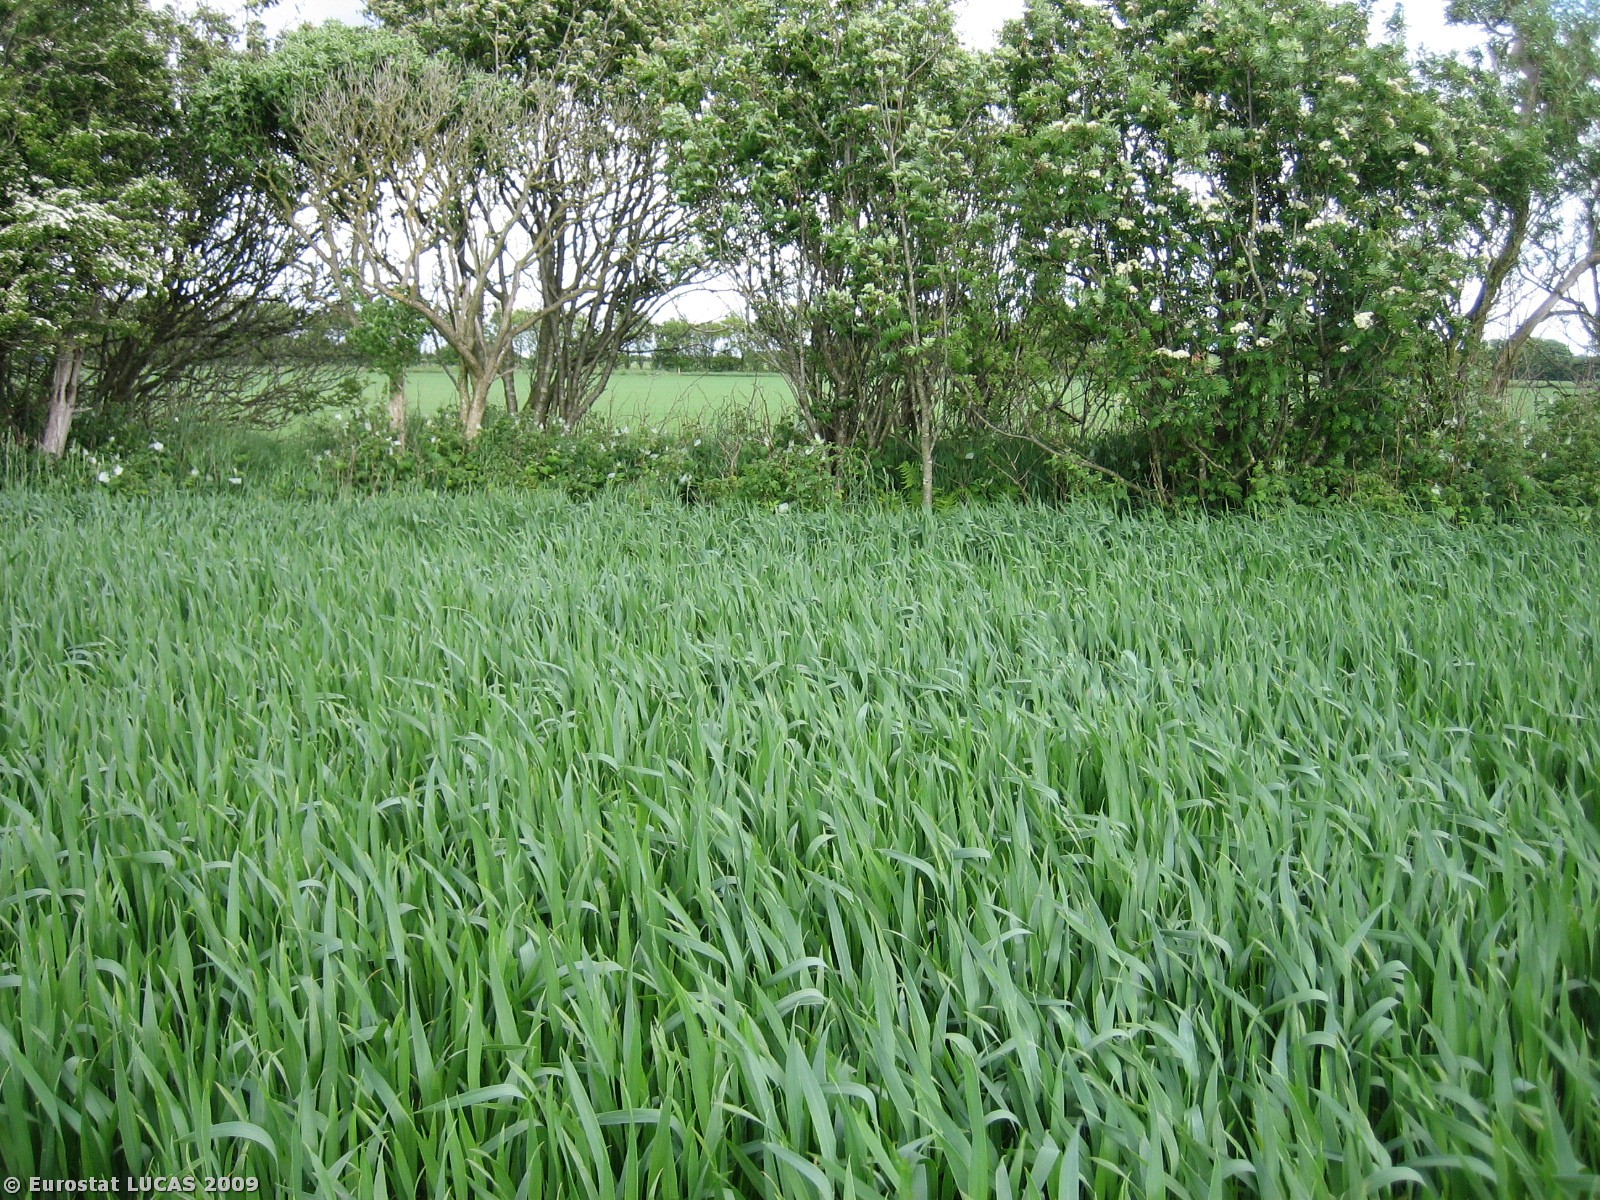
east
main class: Cropland
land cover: Barley
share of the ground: > 75 %
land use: Agriculture (excluding fallow land and kitchen gardens)
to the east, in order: Barley; Shrubland with sparse tree cover; Barley; Grass margins; Ditches and canals; Grass margins; Paved roads, cycling and walking lanes; Grass margins; Broadleaved woodland; Grass margins; Grassland without tree/shrub cover
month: May
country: DK
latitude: 56.0212
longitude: 8.8942
